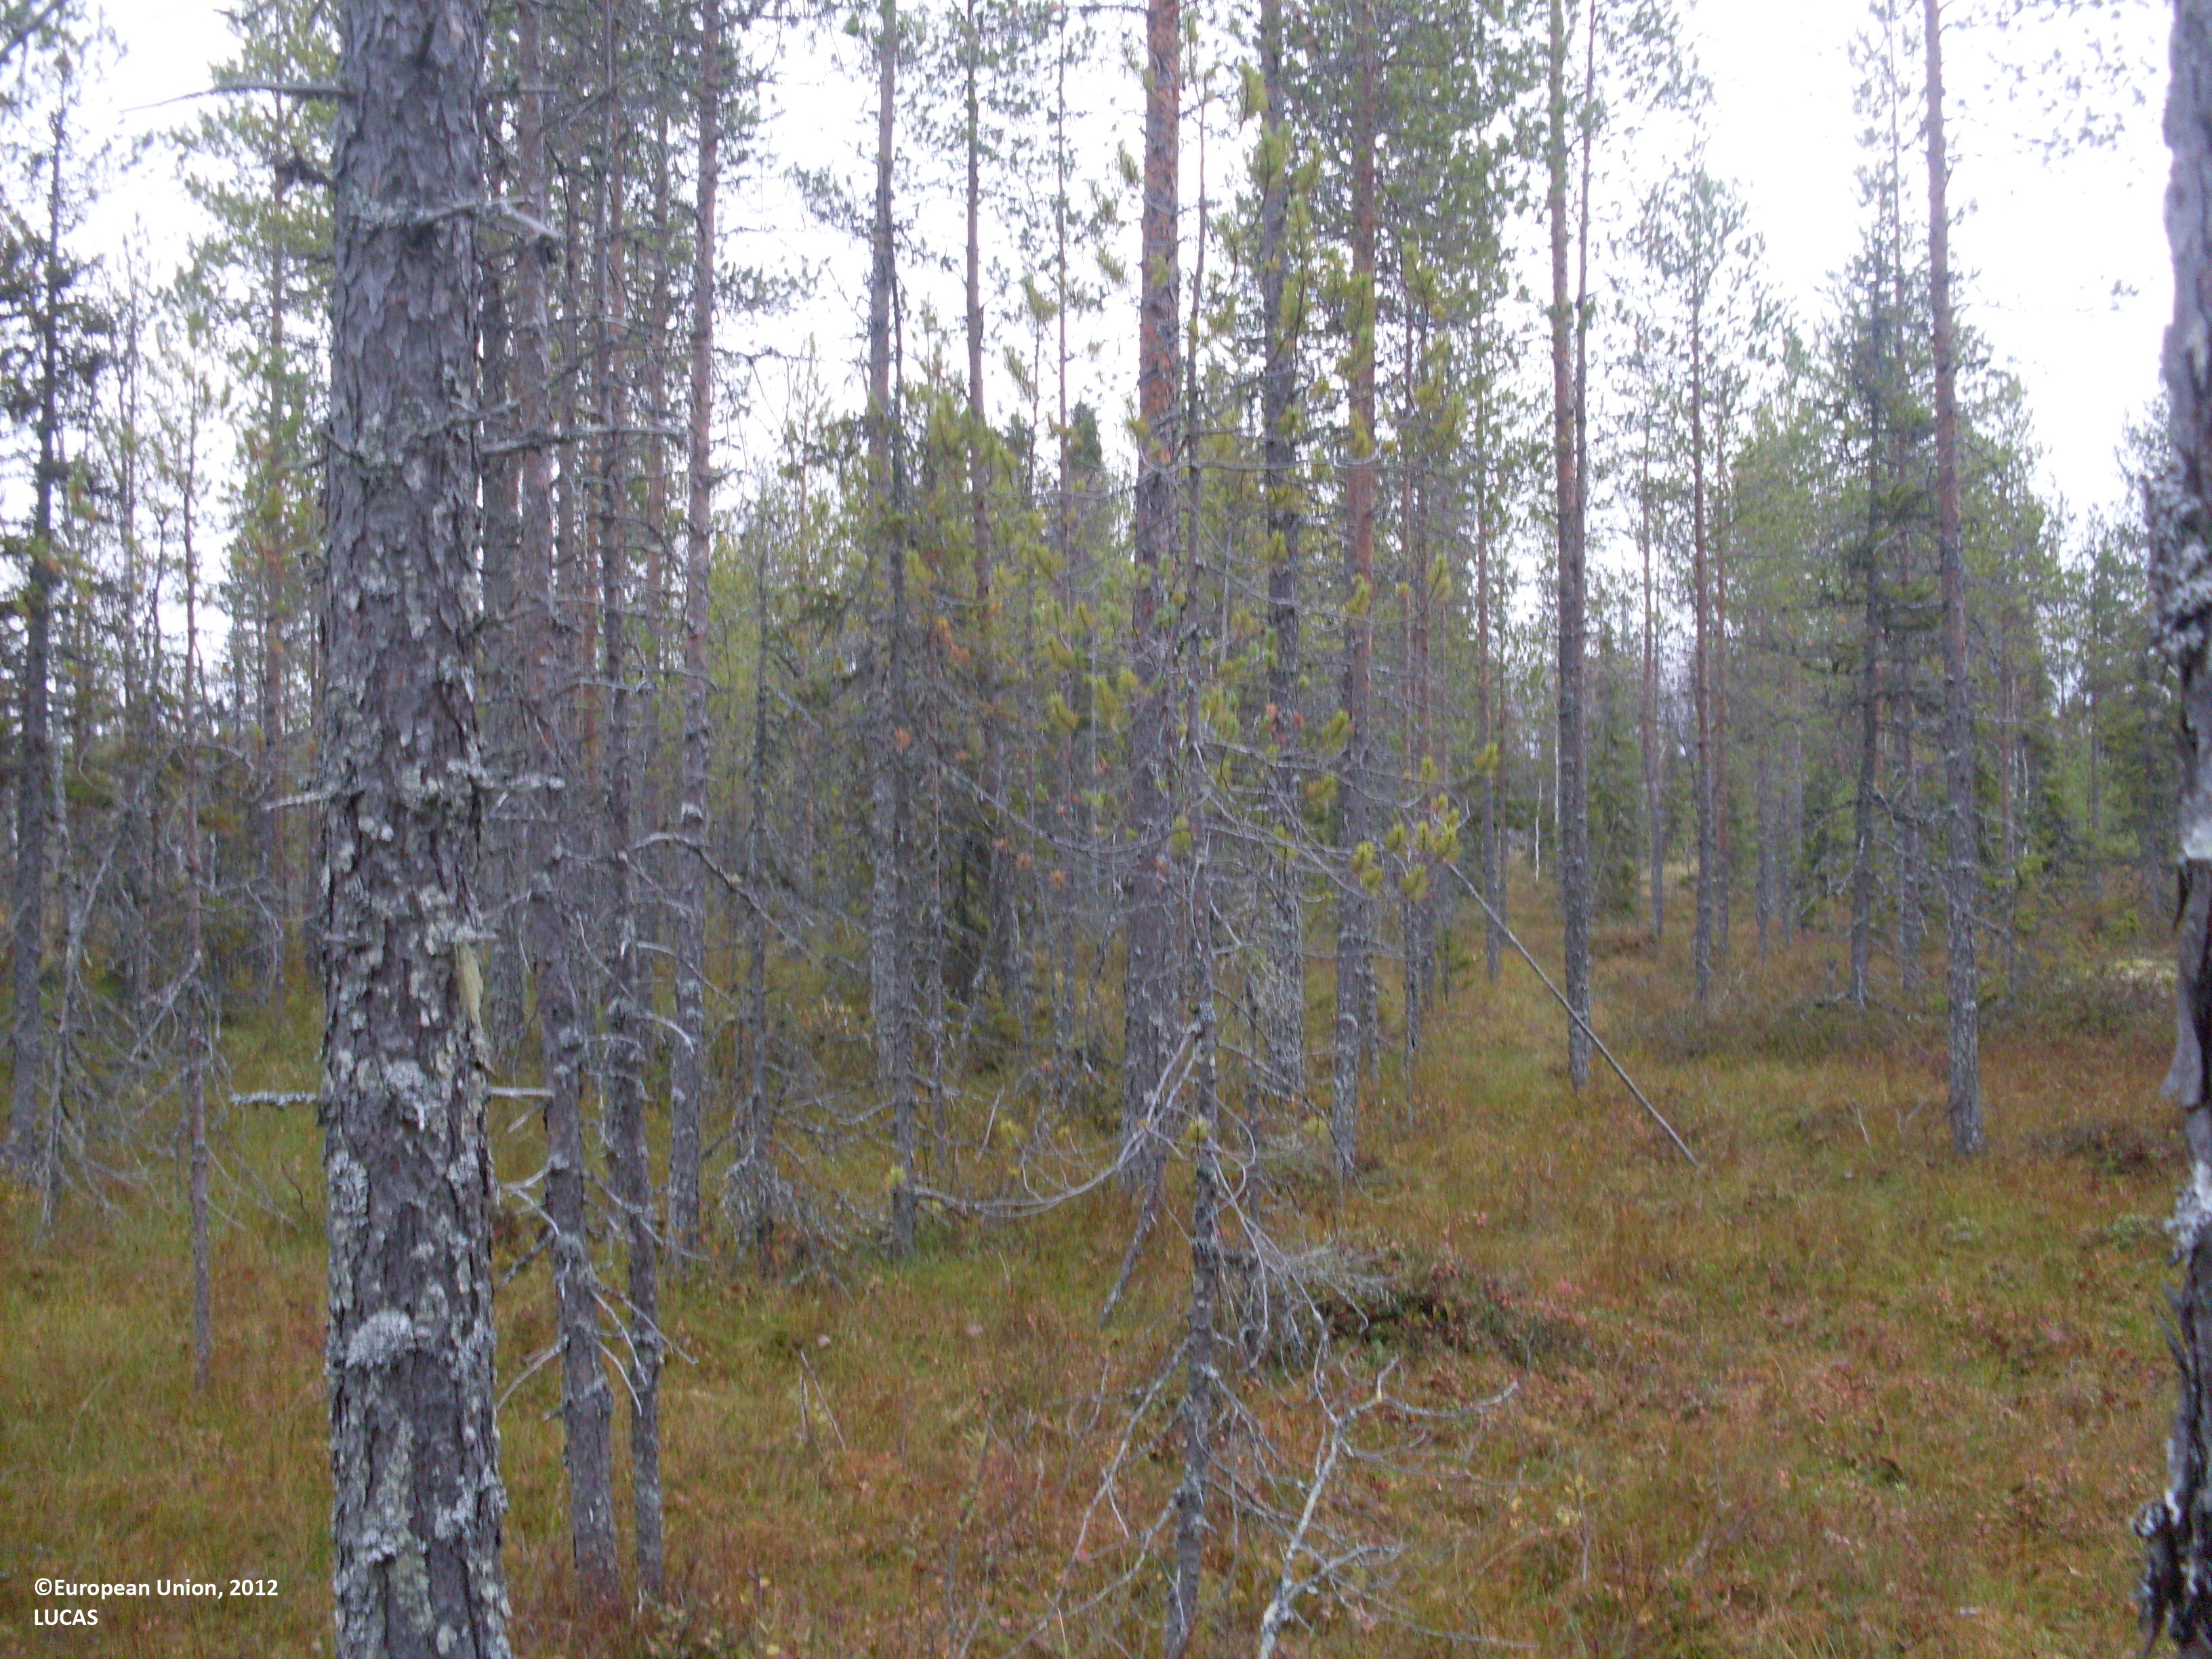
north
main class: Woodland
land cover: Pine dominated coniferous woodland
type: boreal forest
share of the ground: 25 - 50 %
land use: Forestry
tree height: > 5 m
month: September
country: FI
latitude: 64.5513
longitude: 29.6800
